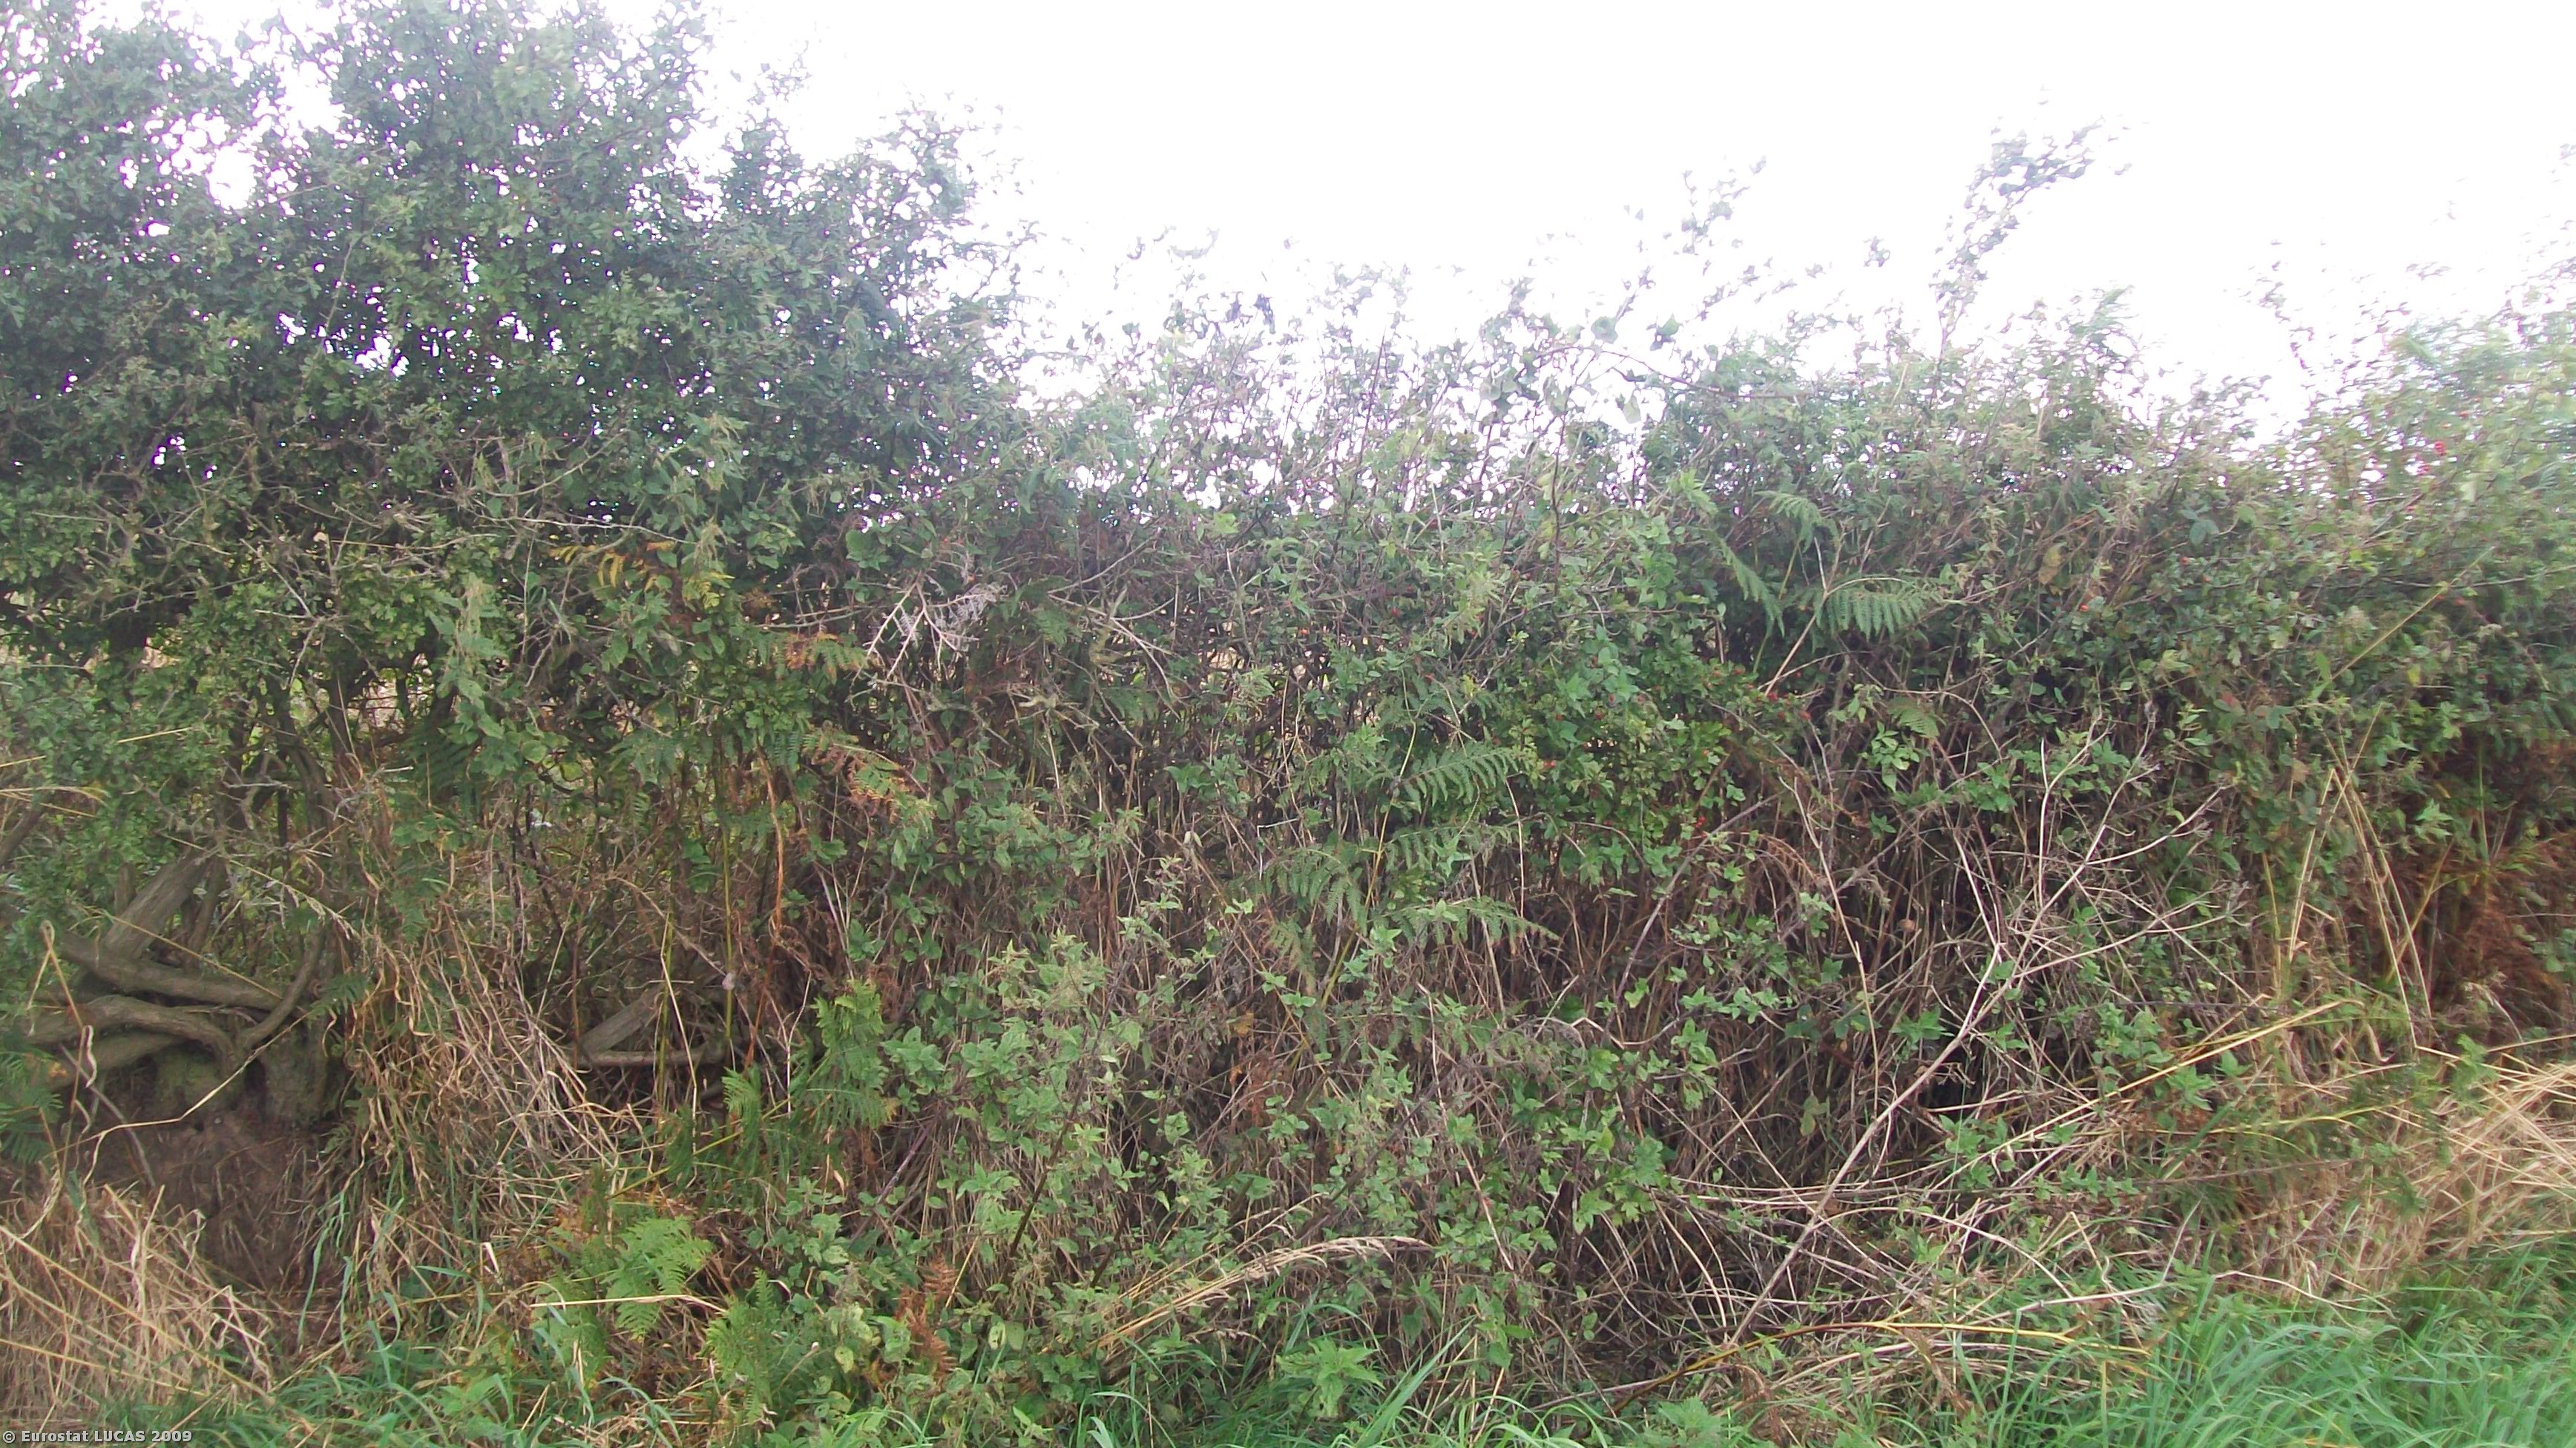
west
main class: Grassland
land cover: Grassland without tree/shrub cover
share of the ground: > 75 %
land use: Agriculture (excluding fallow land and kitchen gardens)
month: September
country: GB
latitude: 52.6892
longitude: -2.5686
